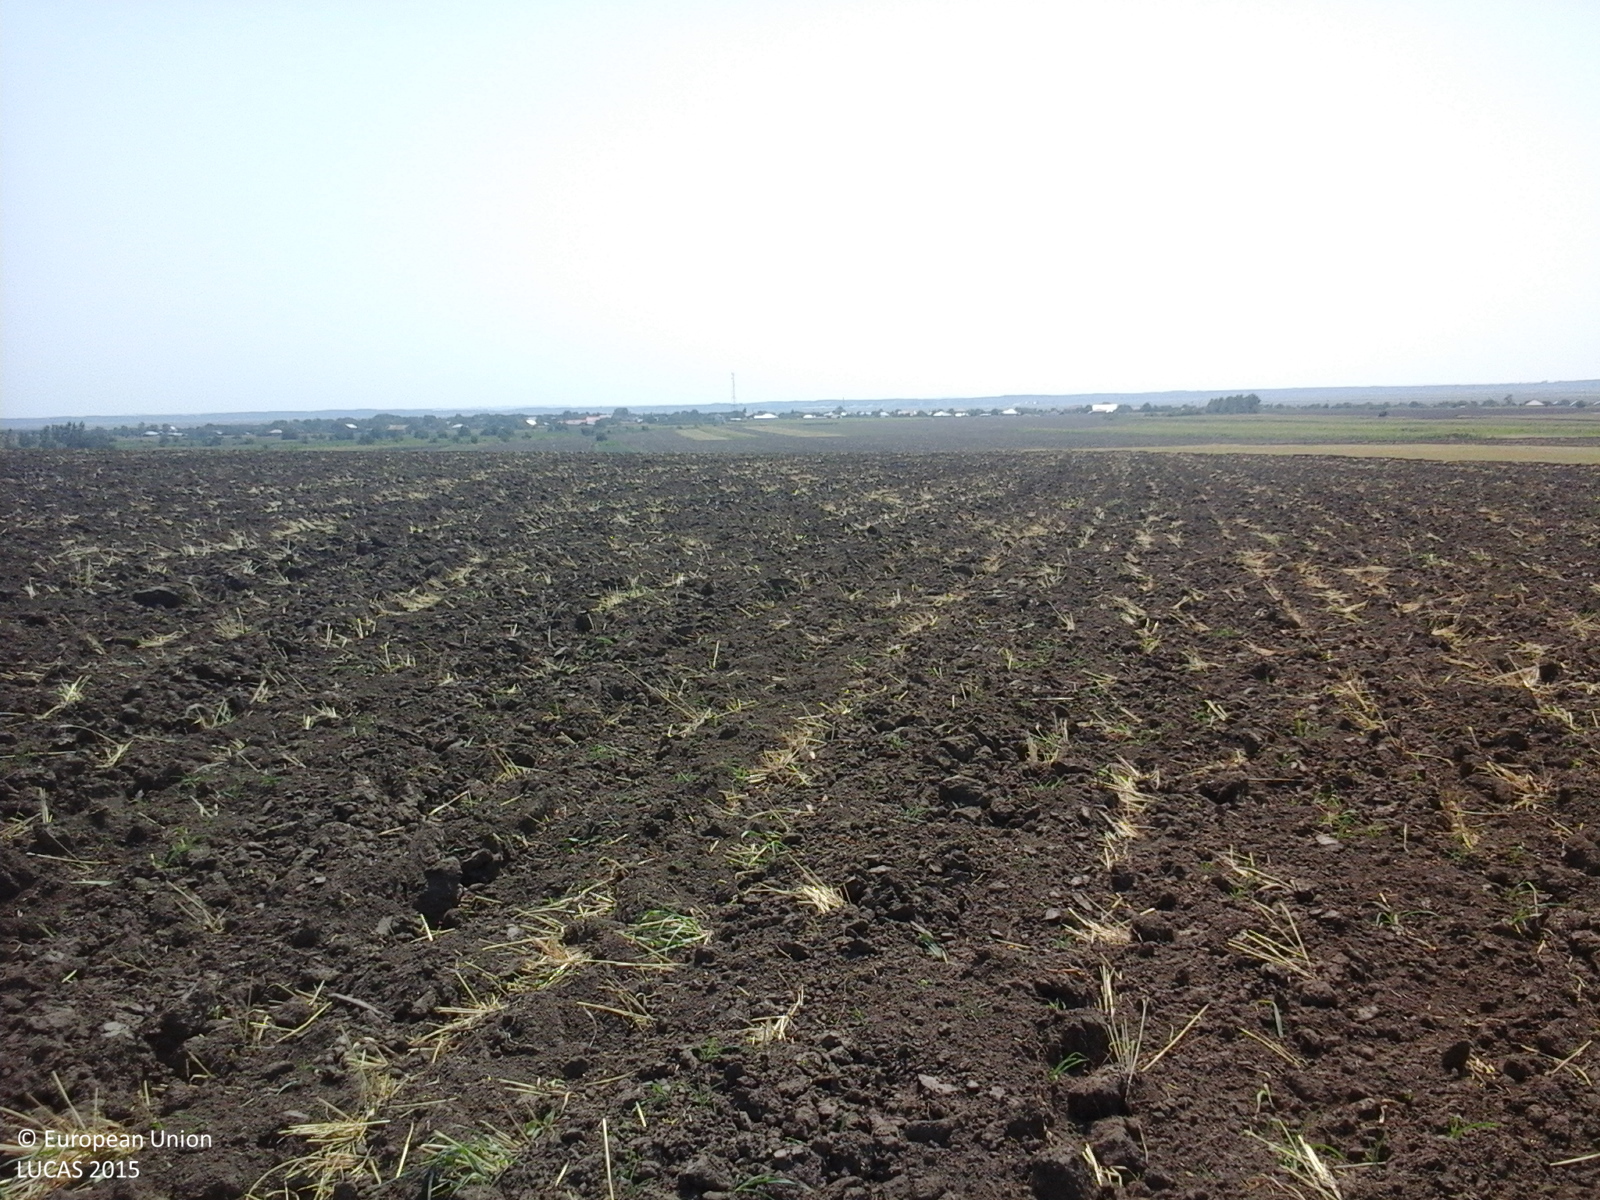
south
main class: Cropland
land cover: Common wheat
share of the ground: < 10 %
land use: Agriculture (excluding fallow land and kitchen gardens)
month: July
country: RO
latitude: 45.4690
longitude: 27.8006
